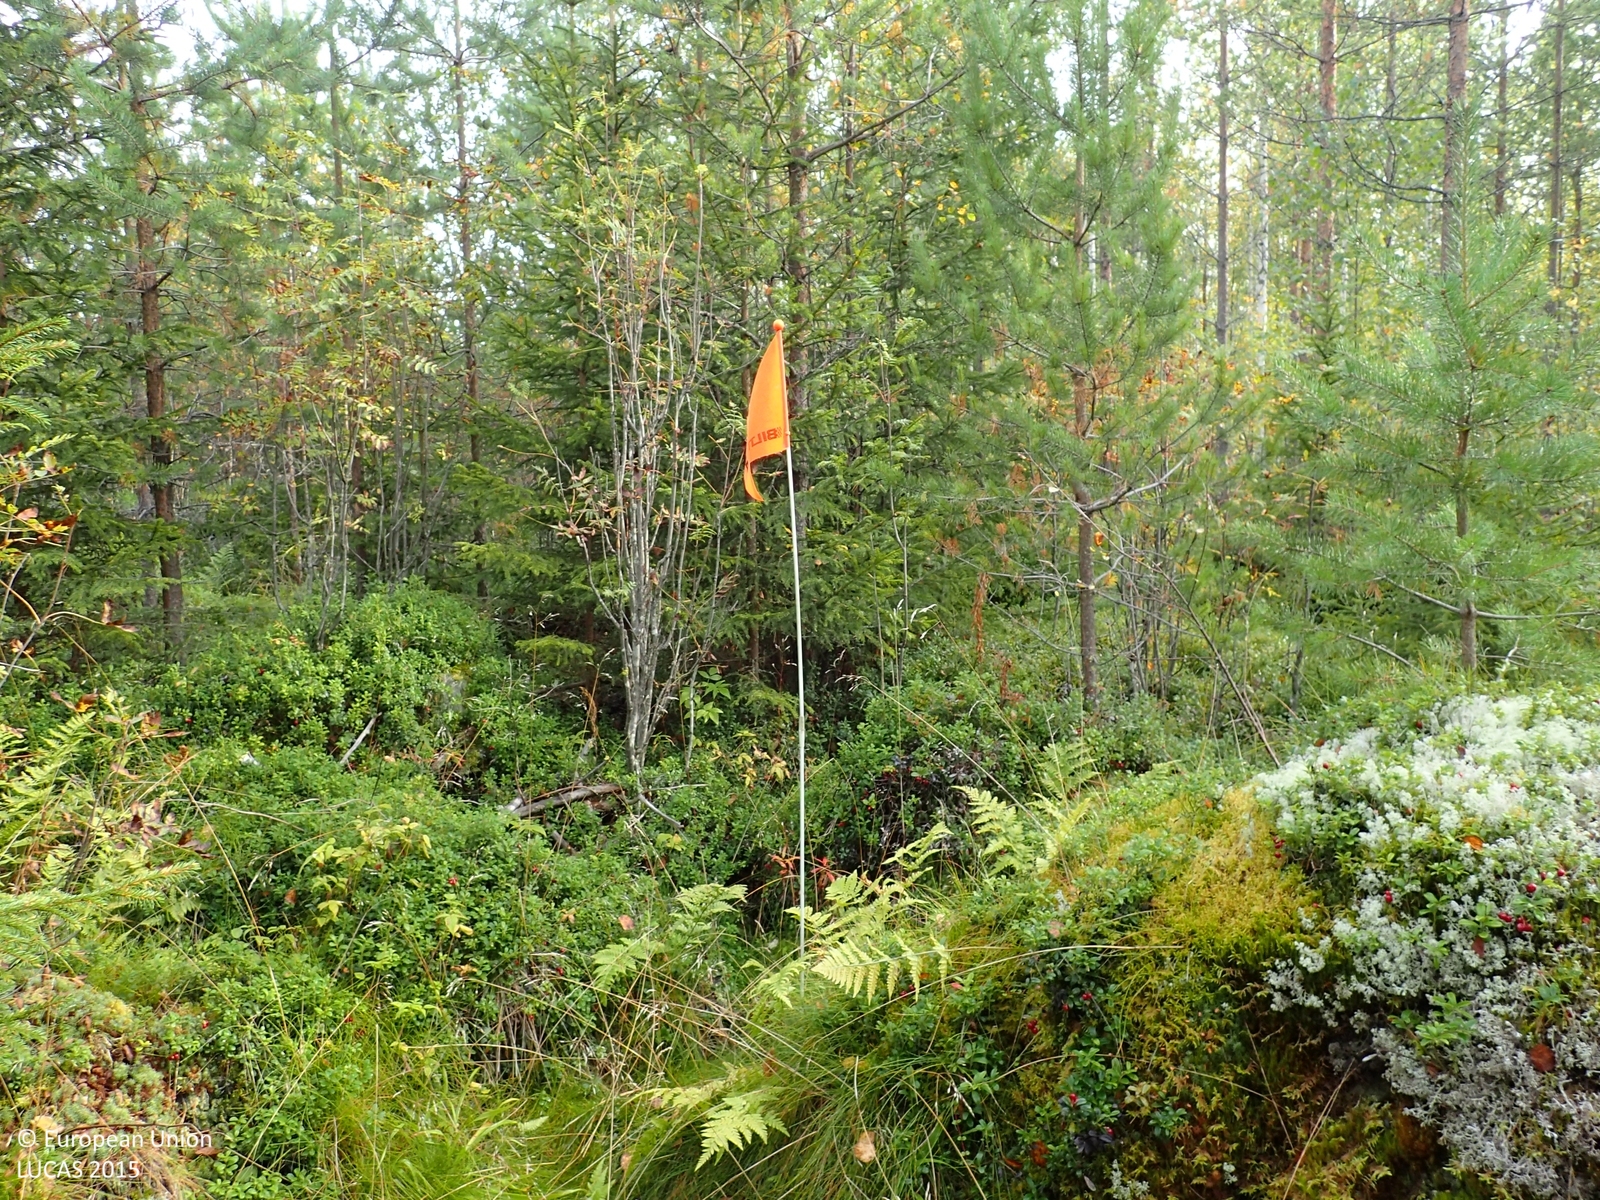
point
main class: Woodland
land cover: Pine dominated mixed woodland
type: boreal forest
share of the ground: > 75 %
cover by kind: coniferous forest trees 50 %, broadleaved forest trees 30 %, shrubs 20 %
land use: Forestry
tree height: < 5 m
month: September
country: FI
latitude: 63.1553
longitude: 25.9762
